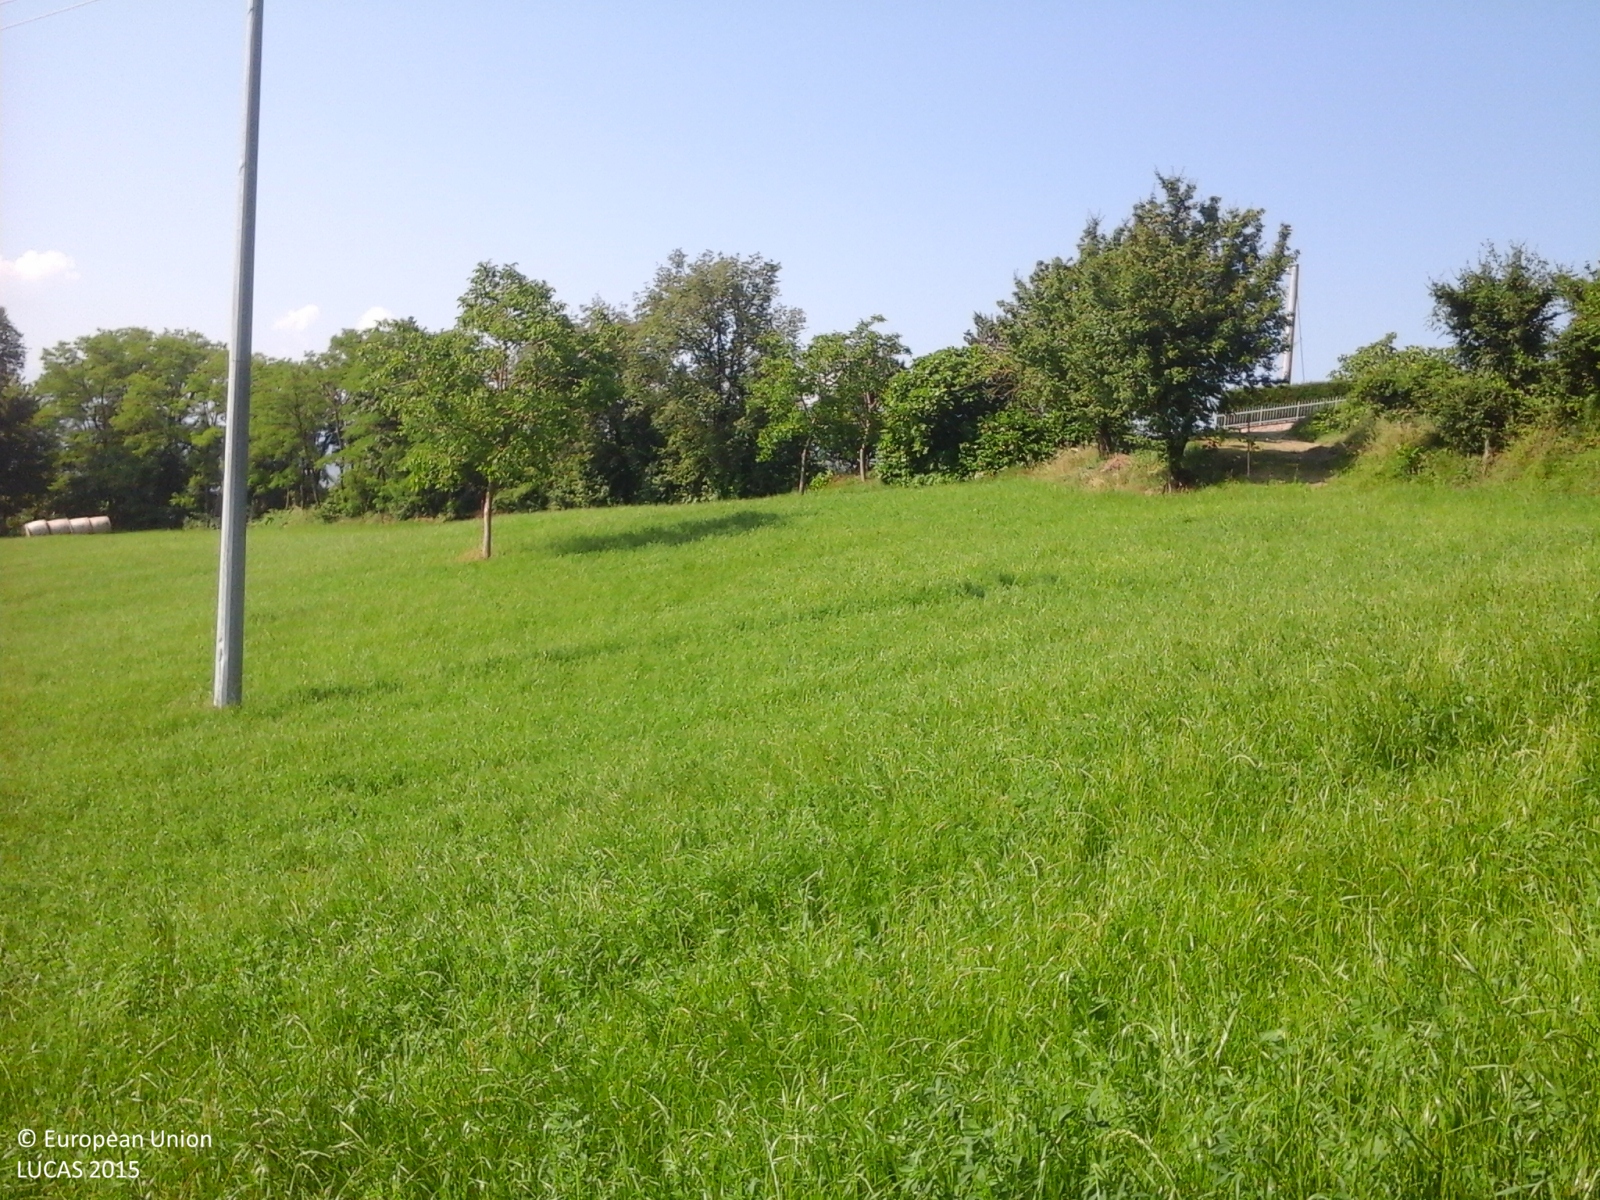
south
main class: Cropland
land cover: Lucerne
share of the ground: > 75 %
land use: Agriculture (excluding fallow land and kitchen gardens)
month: June
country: IT
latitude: 44.4209
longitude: 10.6140
